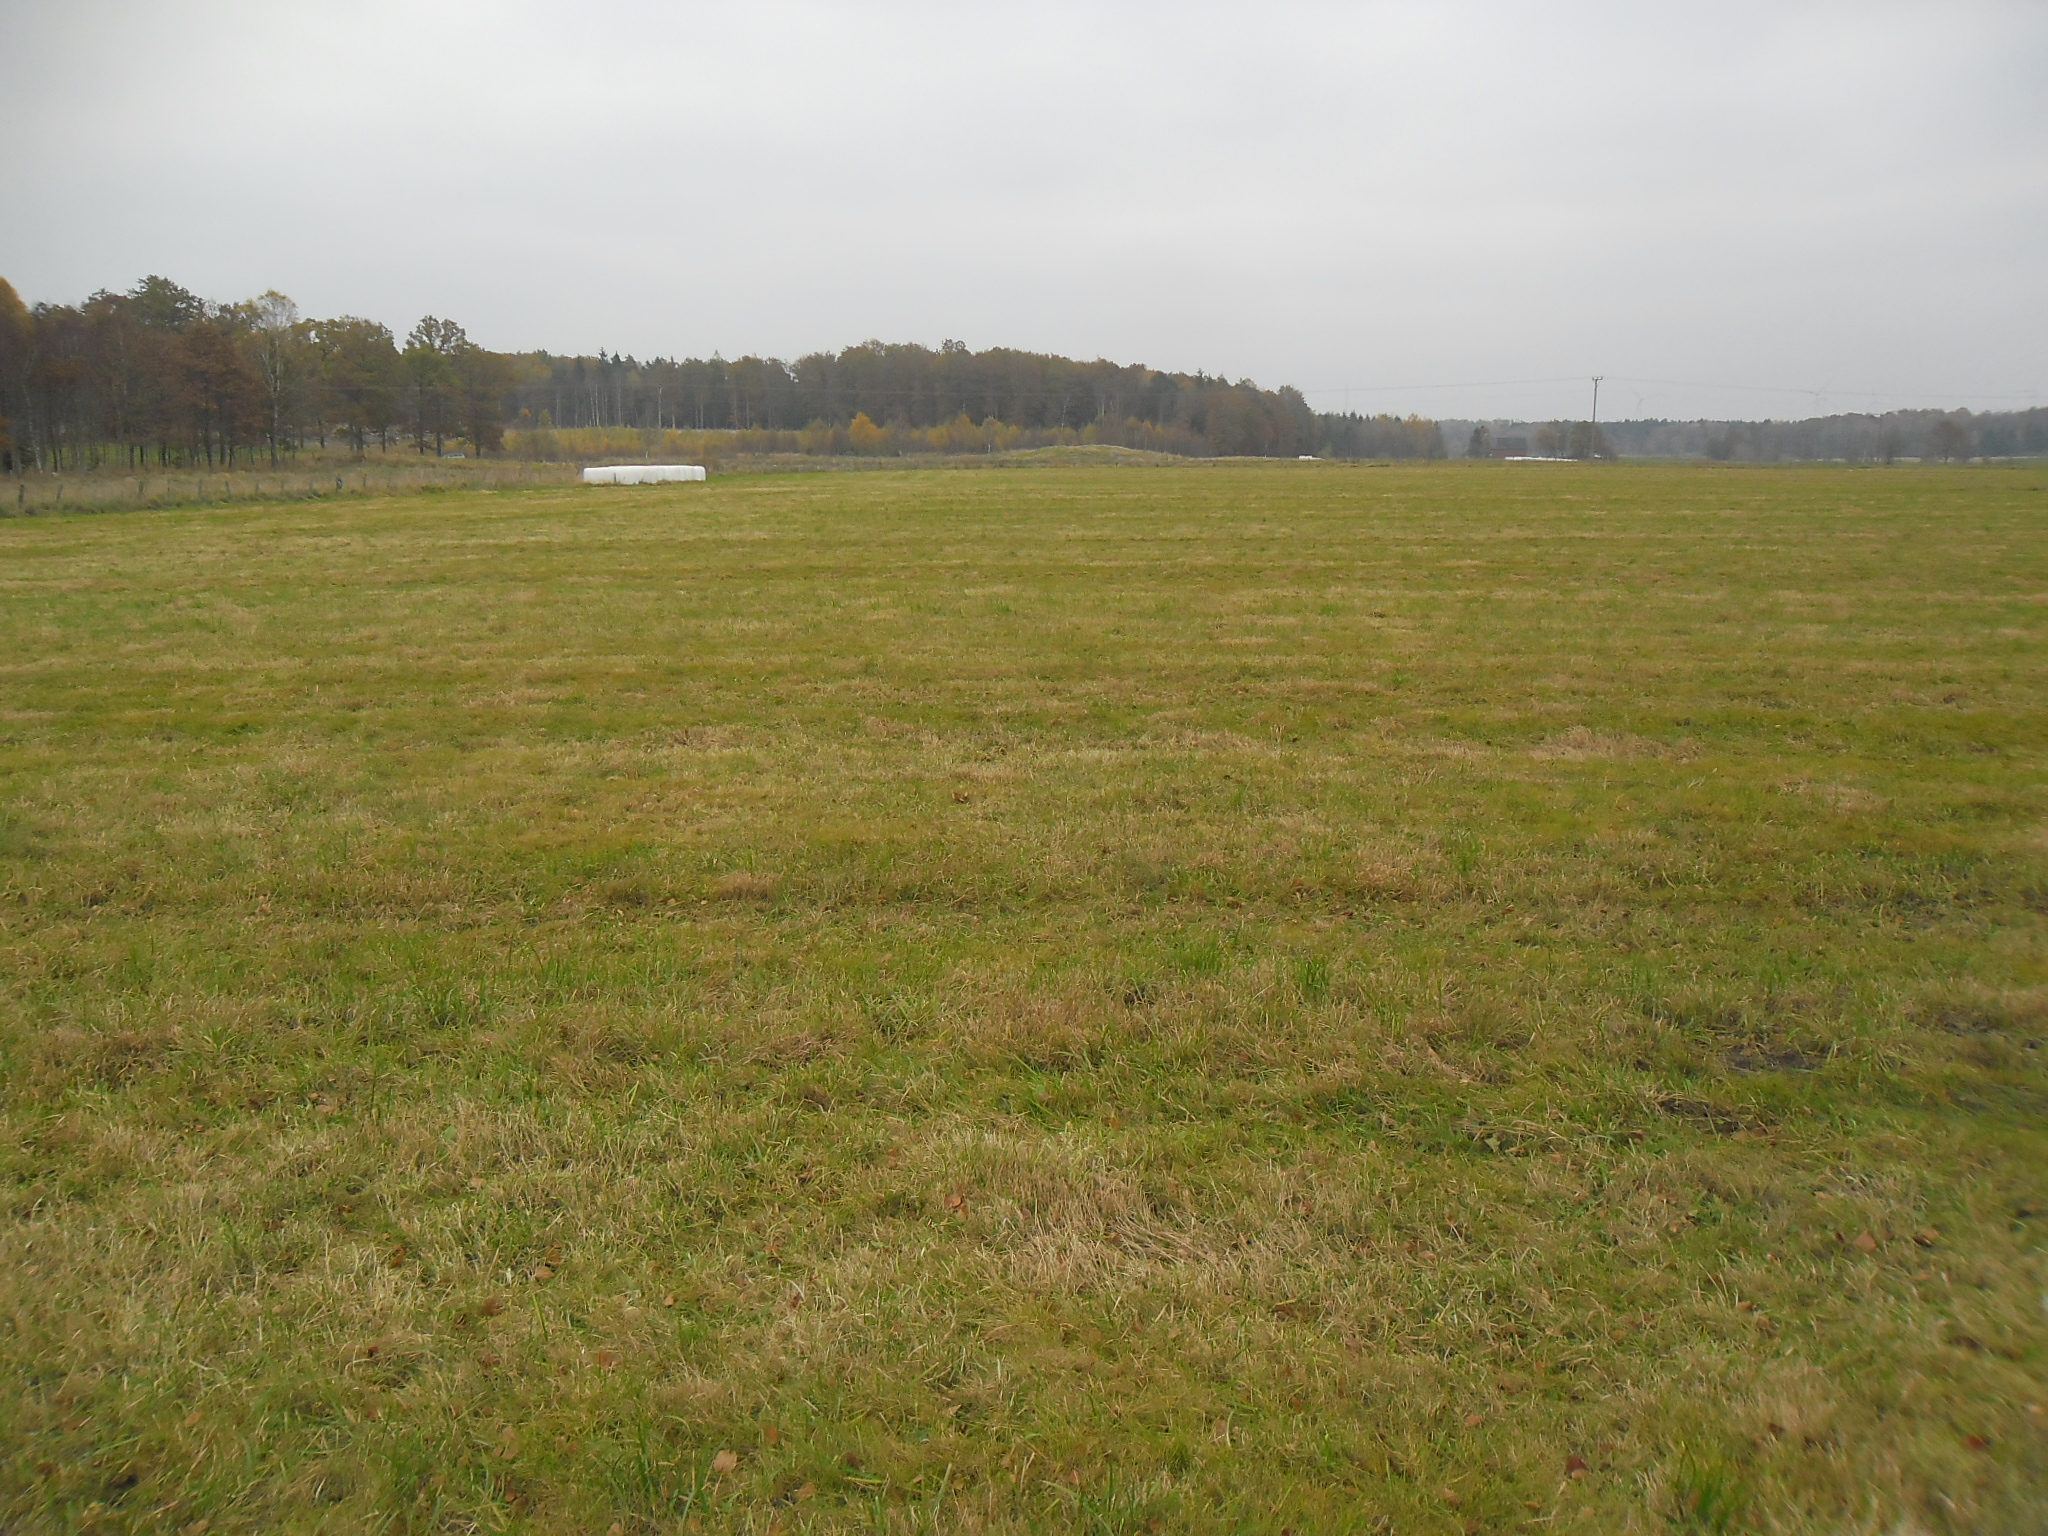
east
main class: Grassland
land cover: Grassland without tree/shrub cover
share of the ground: > 75 %
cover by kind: herbaceous plants 100 %
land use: Agriculture (excluding fallow land and kitchen gardens)
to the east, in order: Grassland without tree/shrub cover; Ditches and canals; Fences; Other bare soil; Inland fresh water bodies; Other bare soil
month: October
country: SE
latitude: 56.4719
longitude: 13.1950
